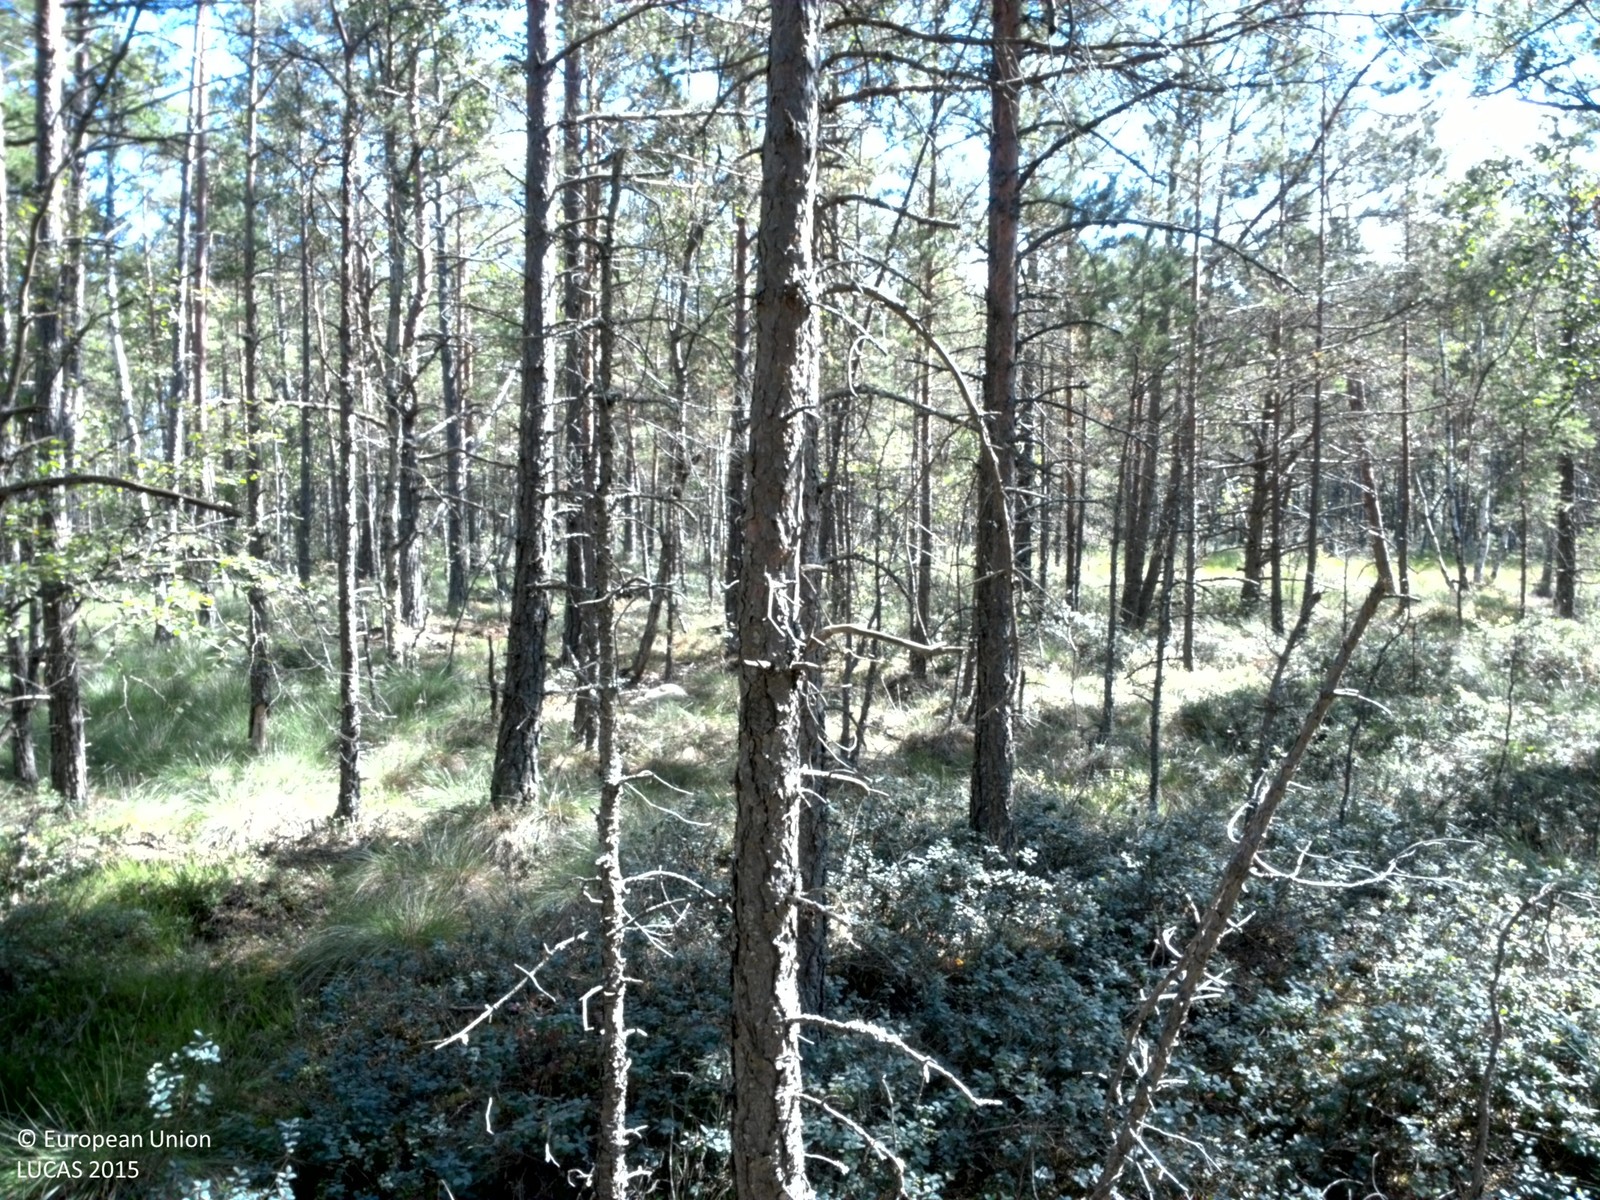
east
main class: Woodland
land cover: Pine dominated mixed woodland
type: boreal forest
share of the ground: 25 - 50 %
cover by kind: coniferous forest trees 30 %, shrubs 30 %, broadleaved forest trees 20 %, lichens and mosses 15 %, herbaceous plants 5 %
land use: Semi-natural and natural areas not in use
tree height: > 5 m
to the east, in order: Pine dominated mixed woodland
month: August
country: SE
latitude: 58.2163
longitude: 13.2458
